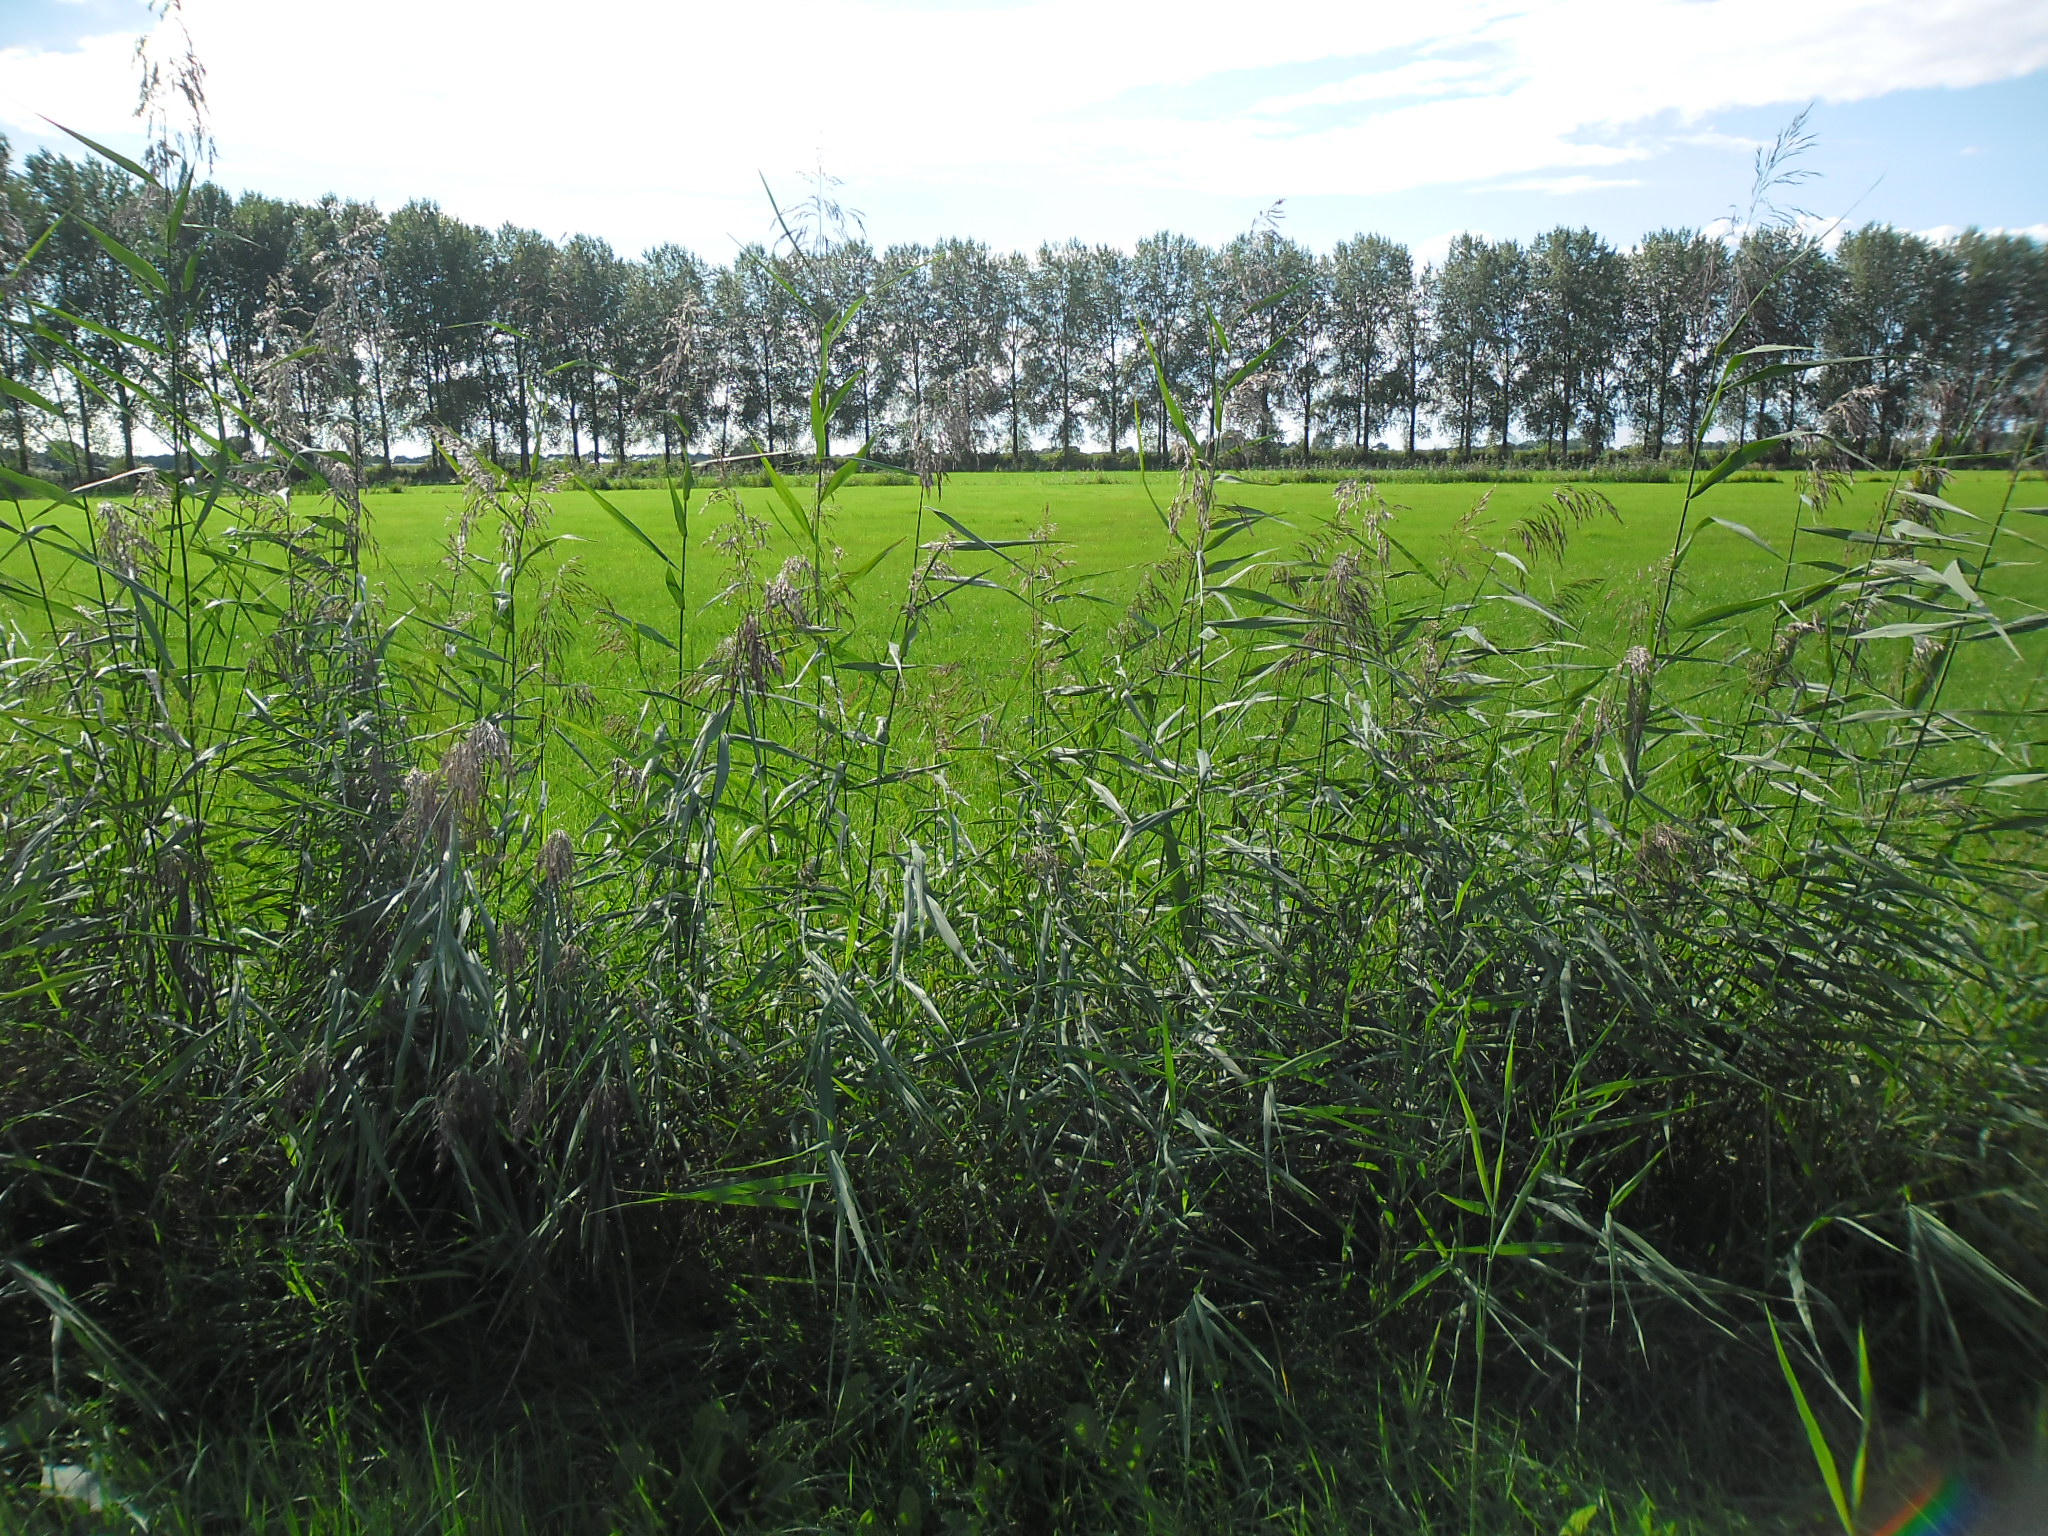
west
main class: Grassland
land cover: Grassland without tree/shrub cover
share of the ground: > 75 %
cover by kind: herbaceous plants 100 %
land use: Agriculture (excluding fallow land and kitchen gardens)
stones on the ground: < 10 %
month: September
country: NL
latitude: 52.0834
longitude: 6.2198
